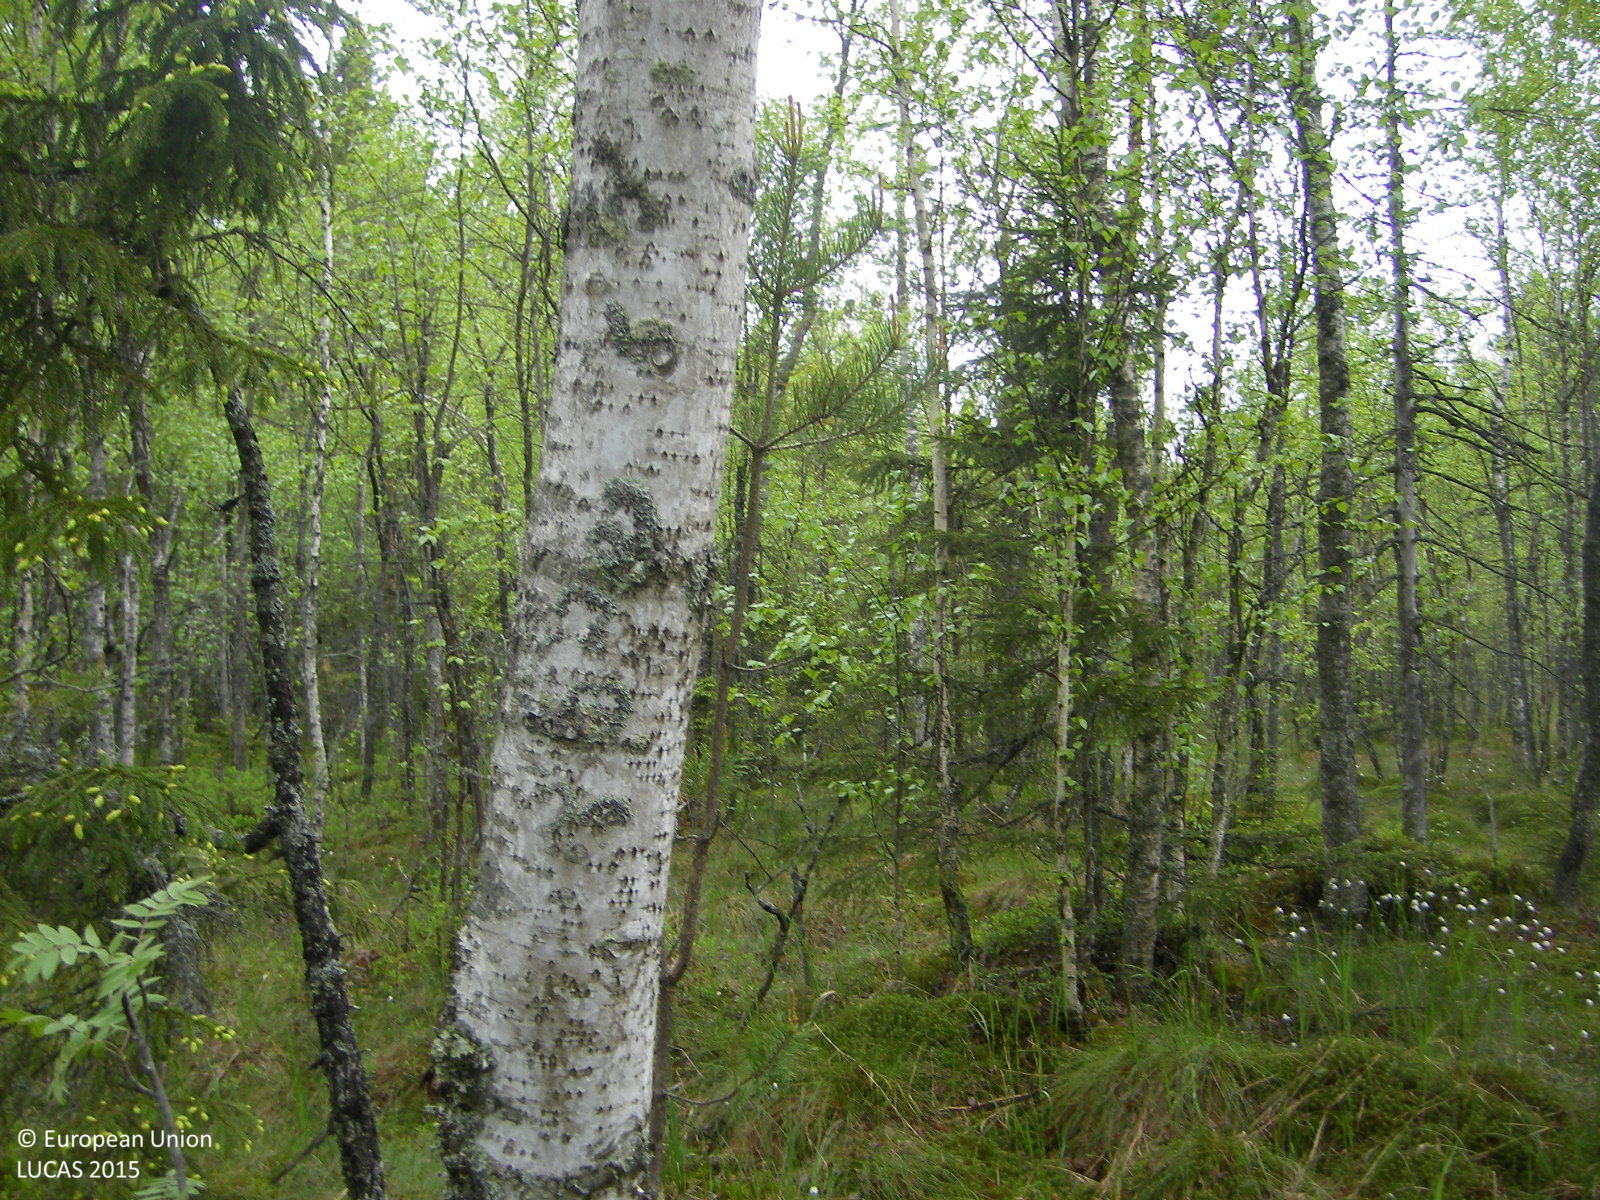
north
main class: Woodland
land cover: Broadleaved woodland
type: mire and swamp forests
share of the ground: 50 - 75 %
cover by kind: broadleaved forest trees 60 %, lichens and mosses 25 %, coniferous forest trees 10 %, herbaceous plants 5 %
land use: Semi-natural and natural areas not in use
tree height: > 5 m
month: June
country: FI
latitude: 60.3163
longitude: 24.7588
